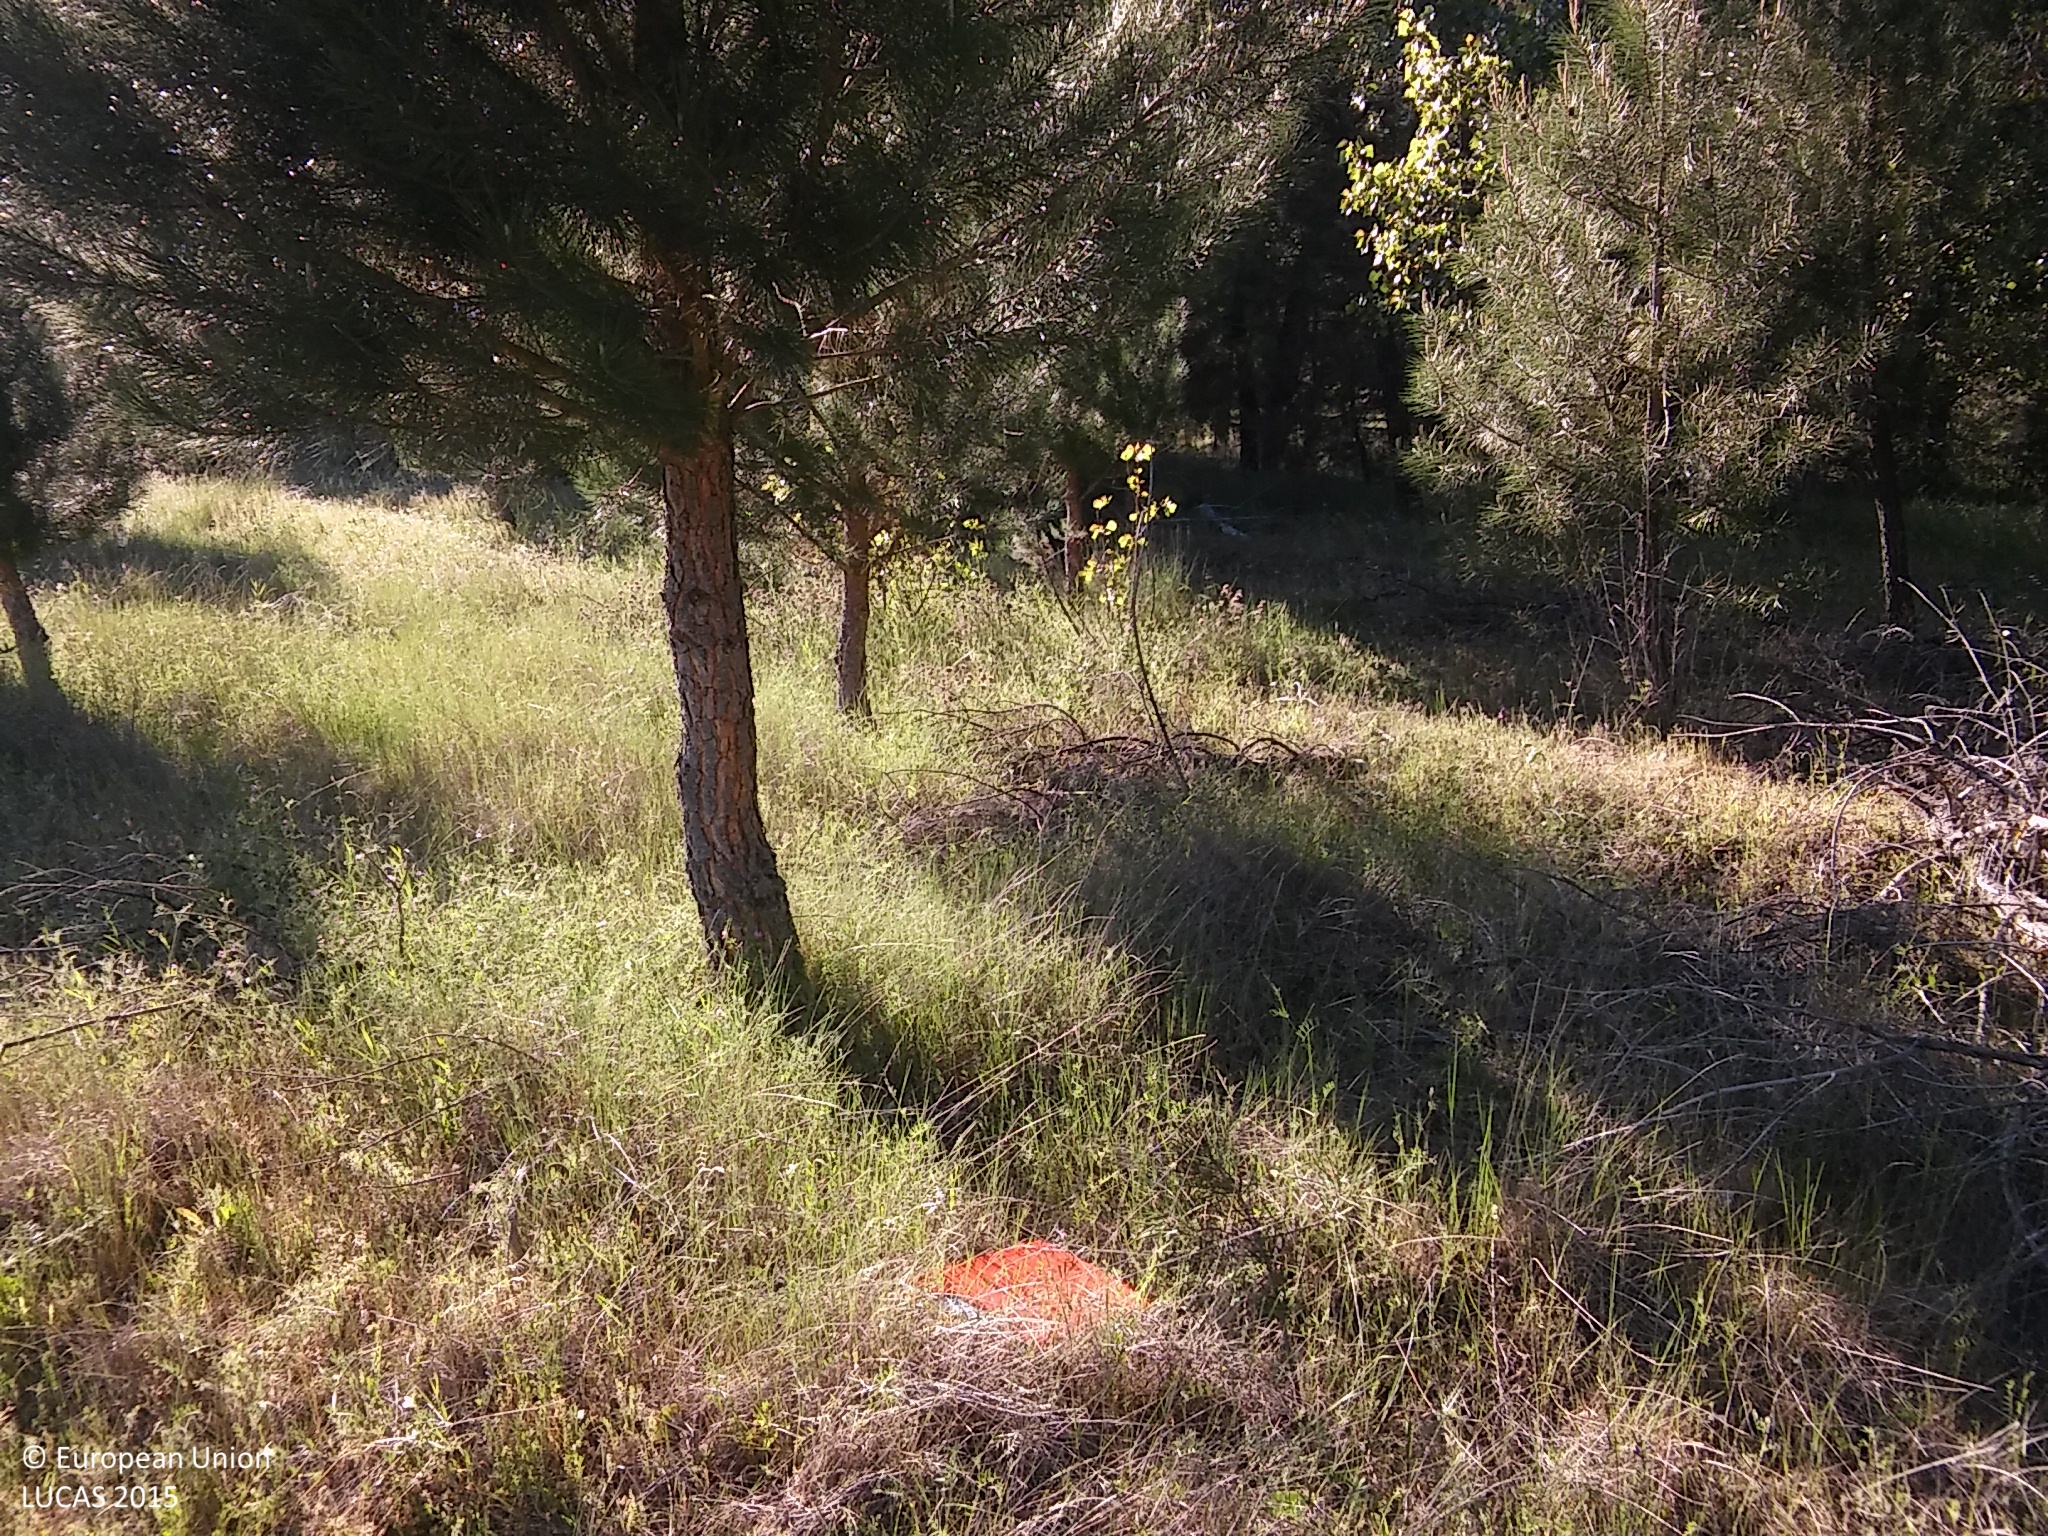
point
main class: Woodland
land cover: Pine dominated coniferous woodland
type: coniferous forest of the mediterranean region
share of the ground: 10 - 25 %
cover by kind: herbaceous plants 65 %, shrubs 25 %, coniferous forest trees 10 %
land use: Forestry
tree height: > 5 m
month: May
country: ES
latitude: 41.3256
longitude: -4.0201
